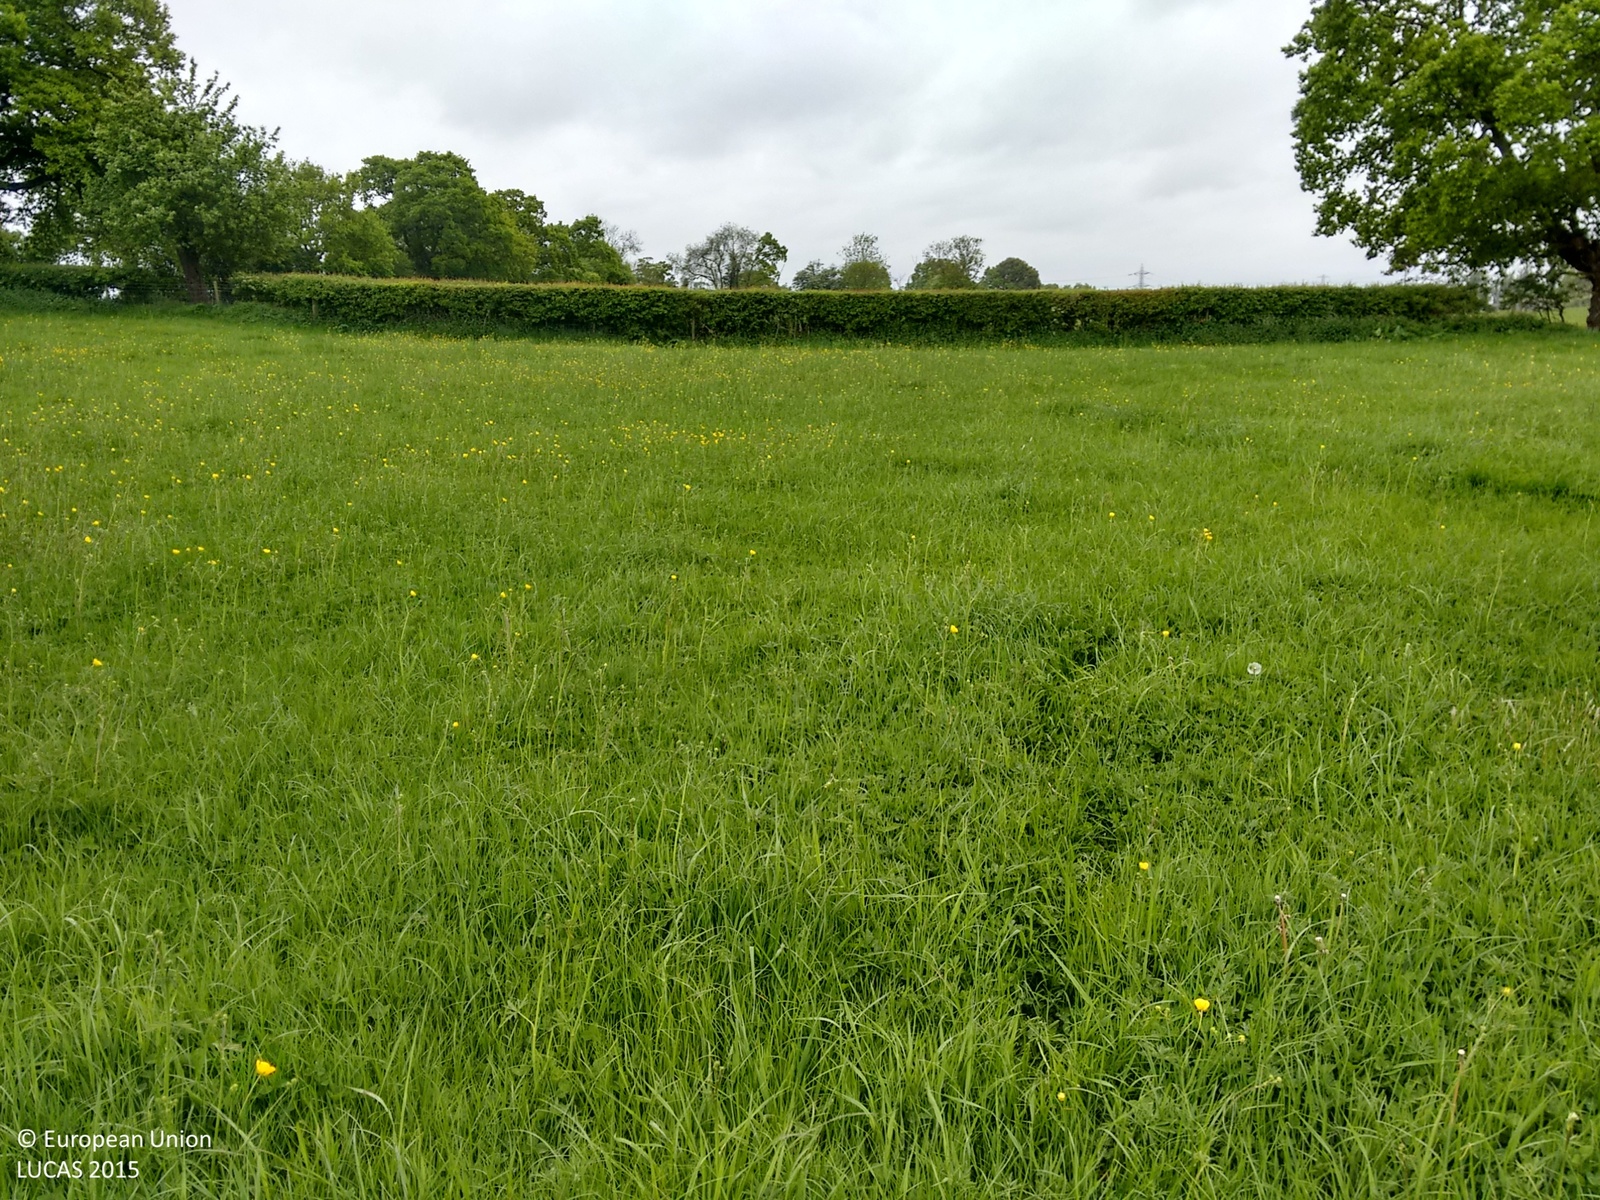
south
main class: Grassland
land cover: Grassland without tree/shrub cover
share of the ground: > 75 %
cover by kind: herbaceous plants 100 %
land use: Agriculture (excluding fallow land and kitchen gardens)
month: May
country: GB
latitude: 52.3308
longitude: -2.1674
